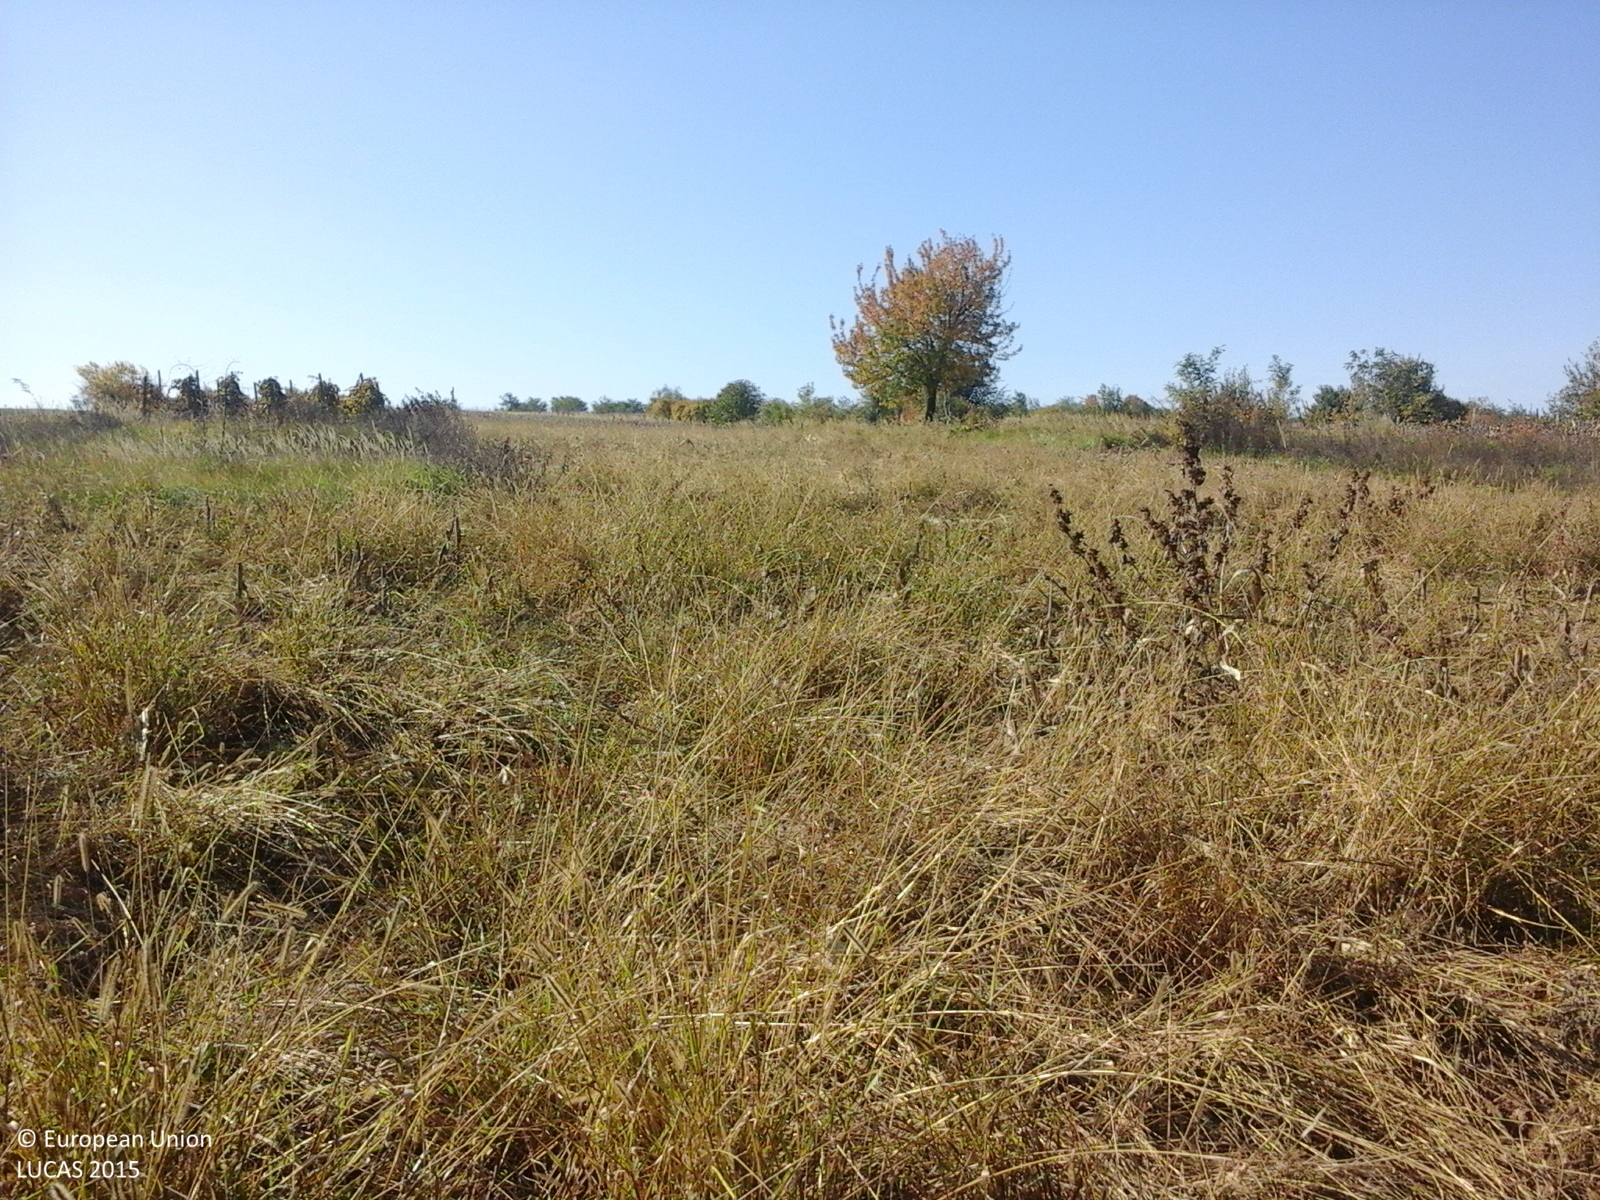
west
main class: Cropland
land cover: Maize
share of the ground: 25 - 50 %
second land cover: Spontaneously vegetated surfaces
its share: > 75 %
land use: Agriculture (excluding fallow land and kitchen gardens)
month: October
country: RO
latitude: 45.9956
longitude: 27.0726
